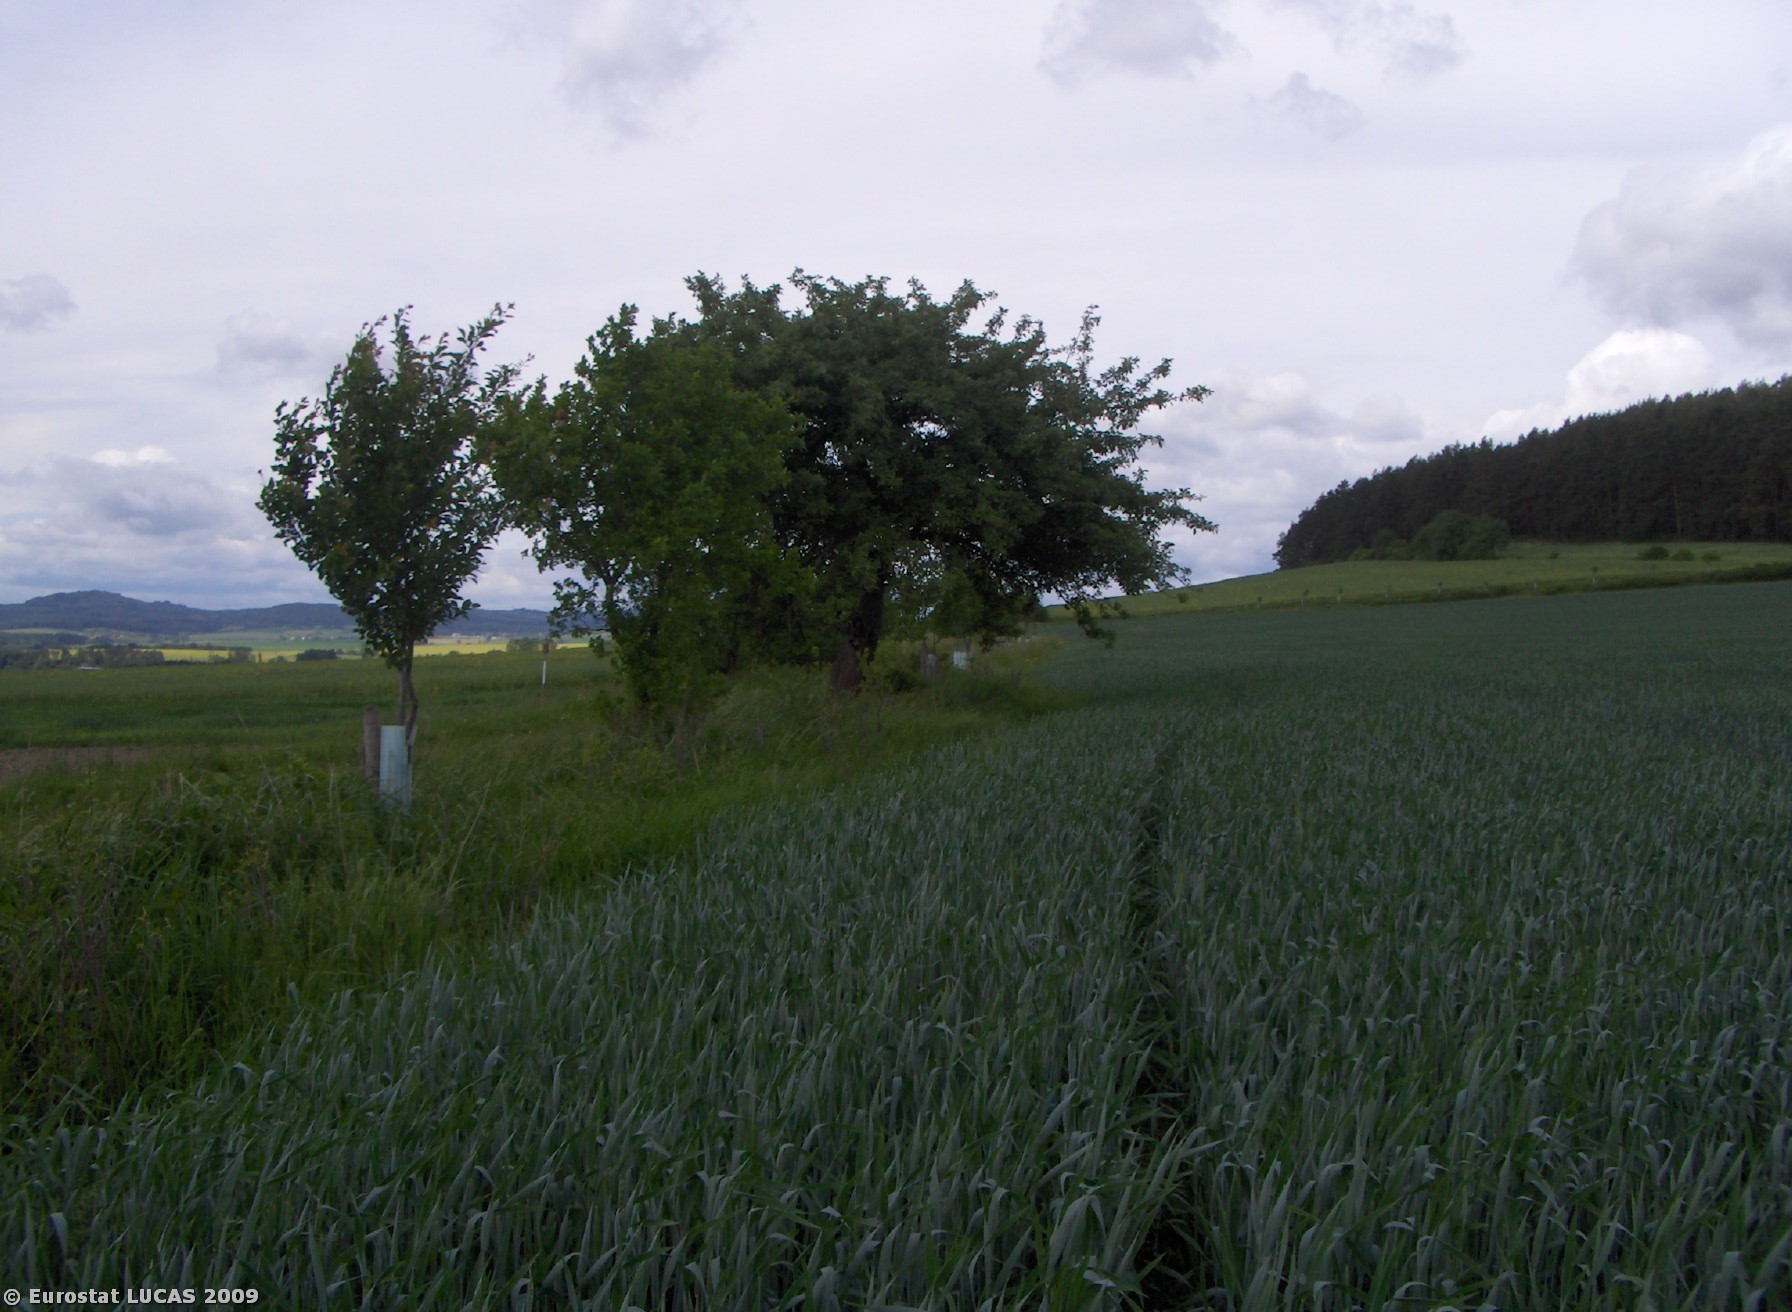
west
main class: Cropland
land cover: Common wheat
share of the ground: > 75 %
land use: Agriculture (excluding fallow land and kitchen gardens)
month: May
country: CZ
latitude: 49.3274
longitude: 14.3353
